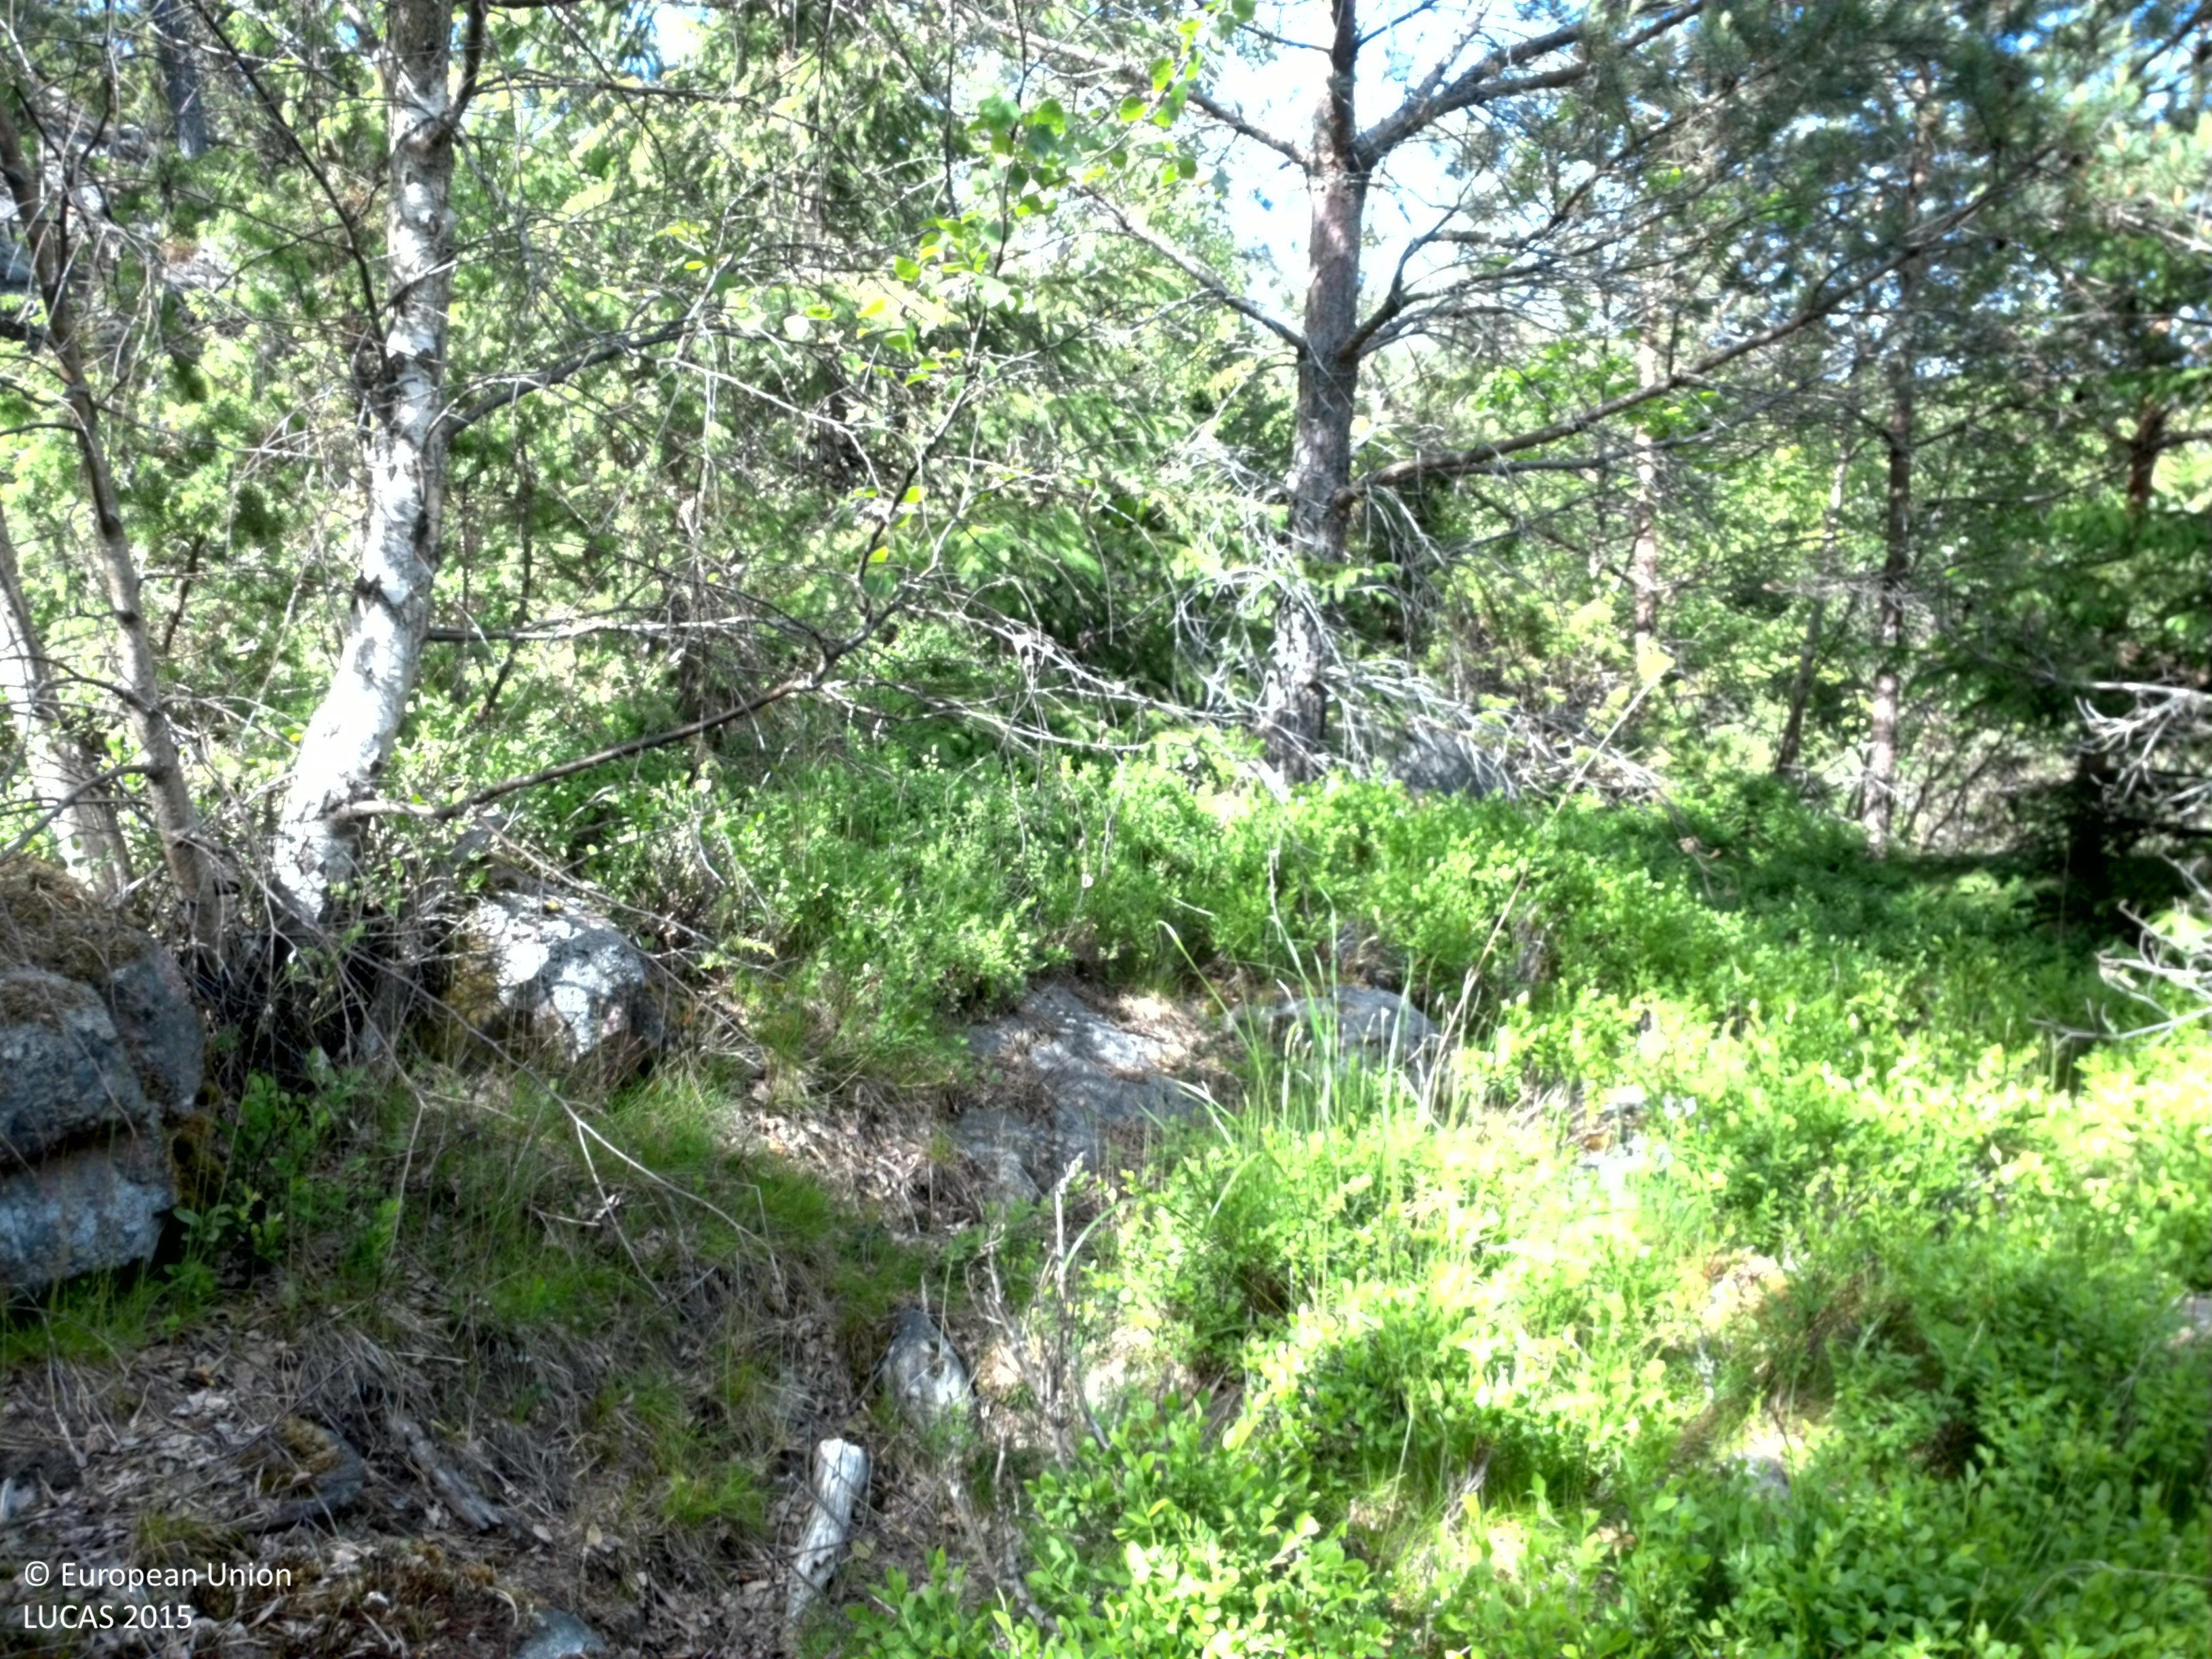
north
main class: Woodland
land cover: Pine dominated coniferous woodland
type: boreal forest
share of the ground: 10 - 25 %
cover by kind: shrubs 50 %, coniferous forest trees 20 %, lichens and mosses 20 %, broadleaved forest trees 5 %, herbaceous plants 5 %
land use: Forestry
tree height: < 5 m
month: June
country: SE
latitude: 58.6843
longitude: 16.3257
